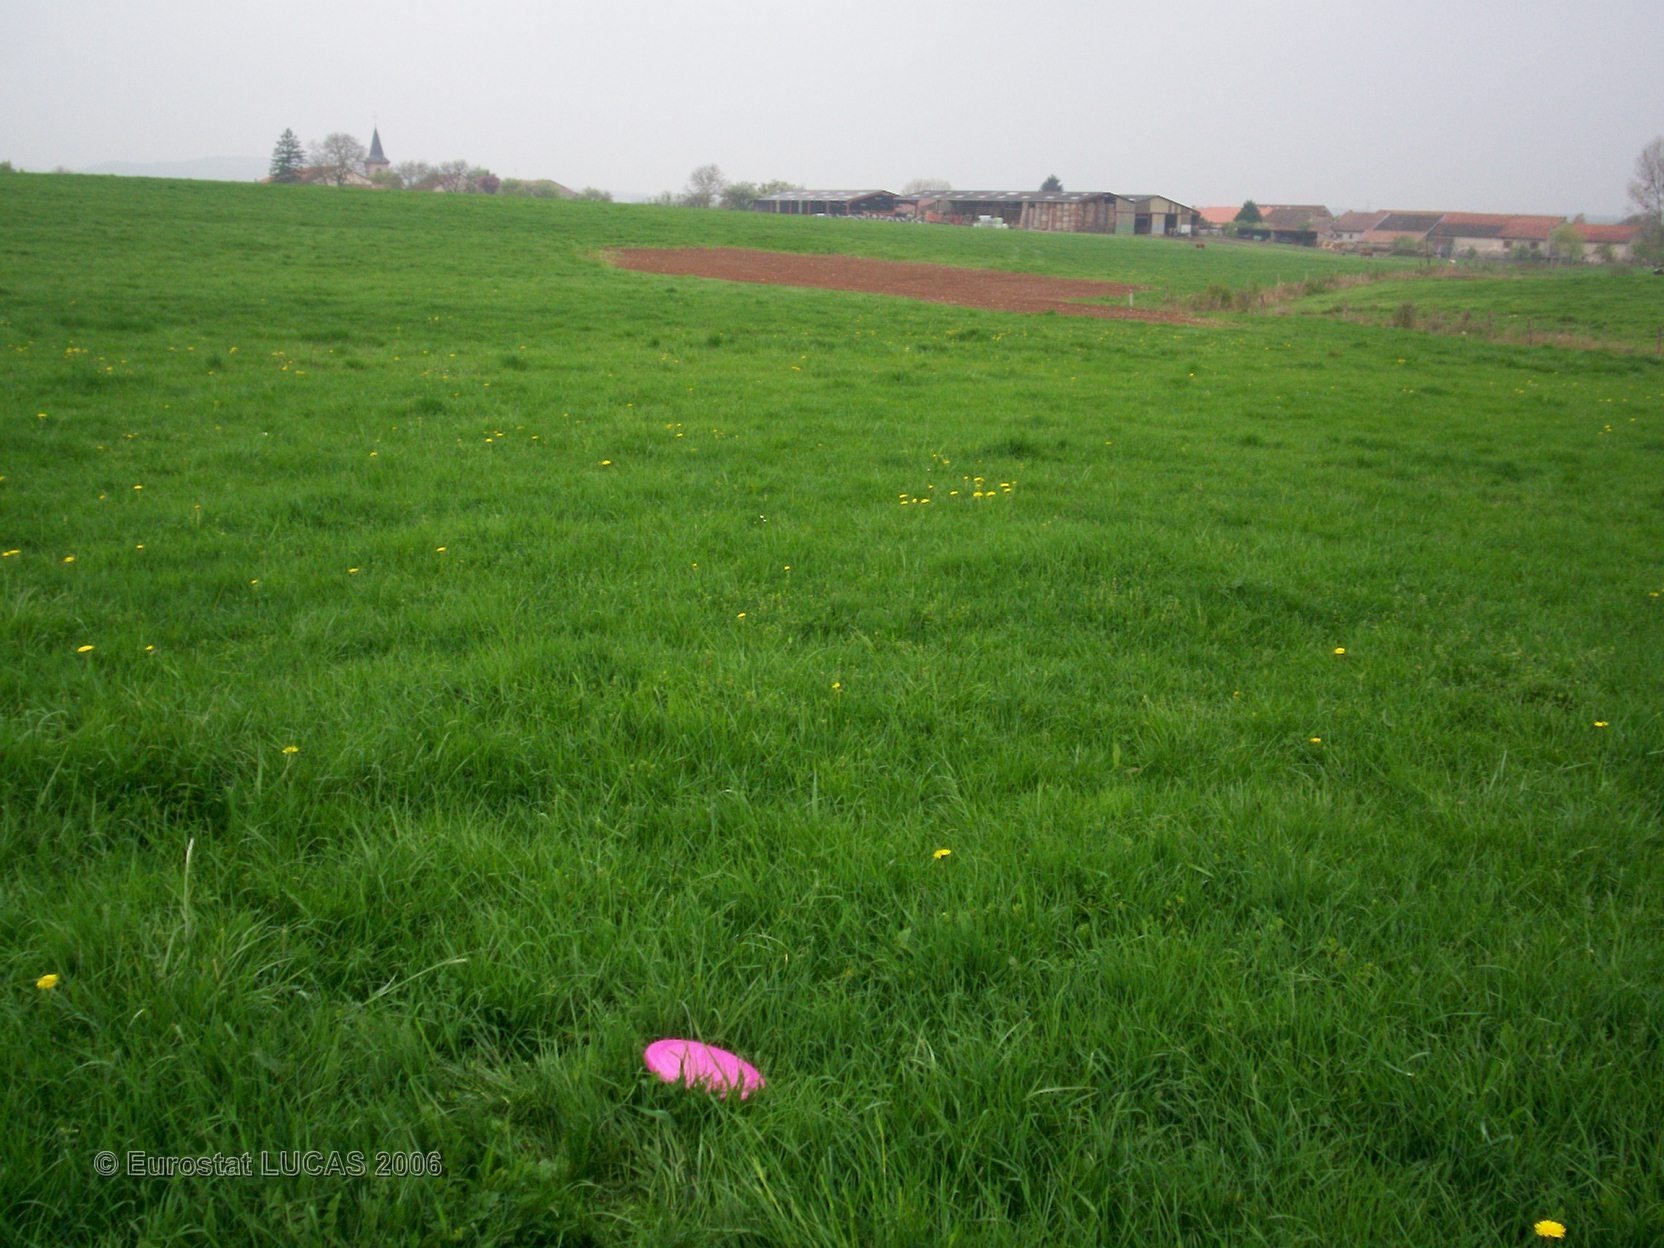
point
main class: Grassland
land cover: Grassland without tree/shrub cover
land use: Agriculture (excluding fallow land and kitchen gardens)
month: April
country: FR
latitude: 48.9152
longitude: 6.7936
